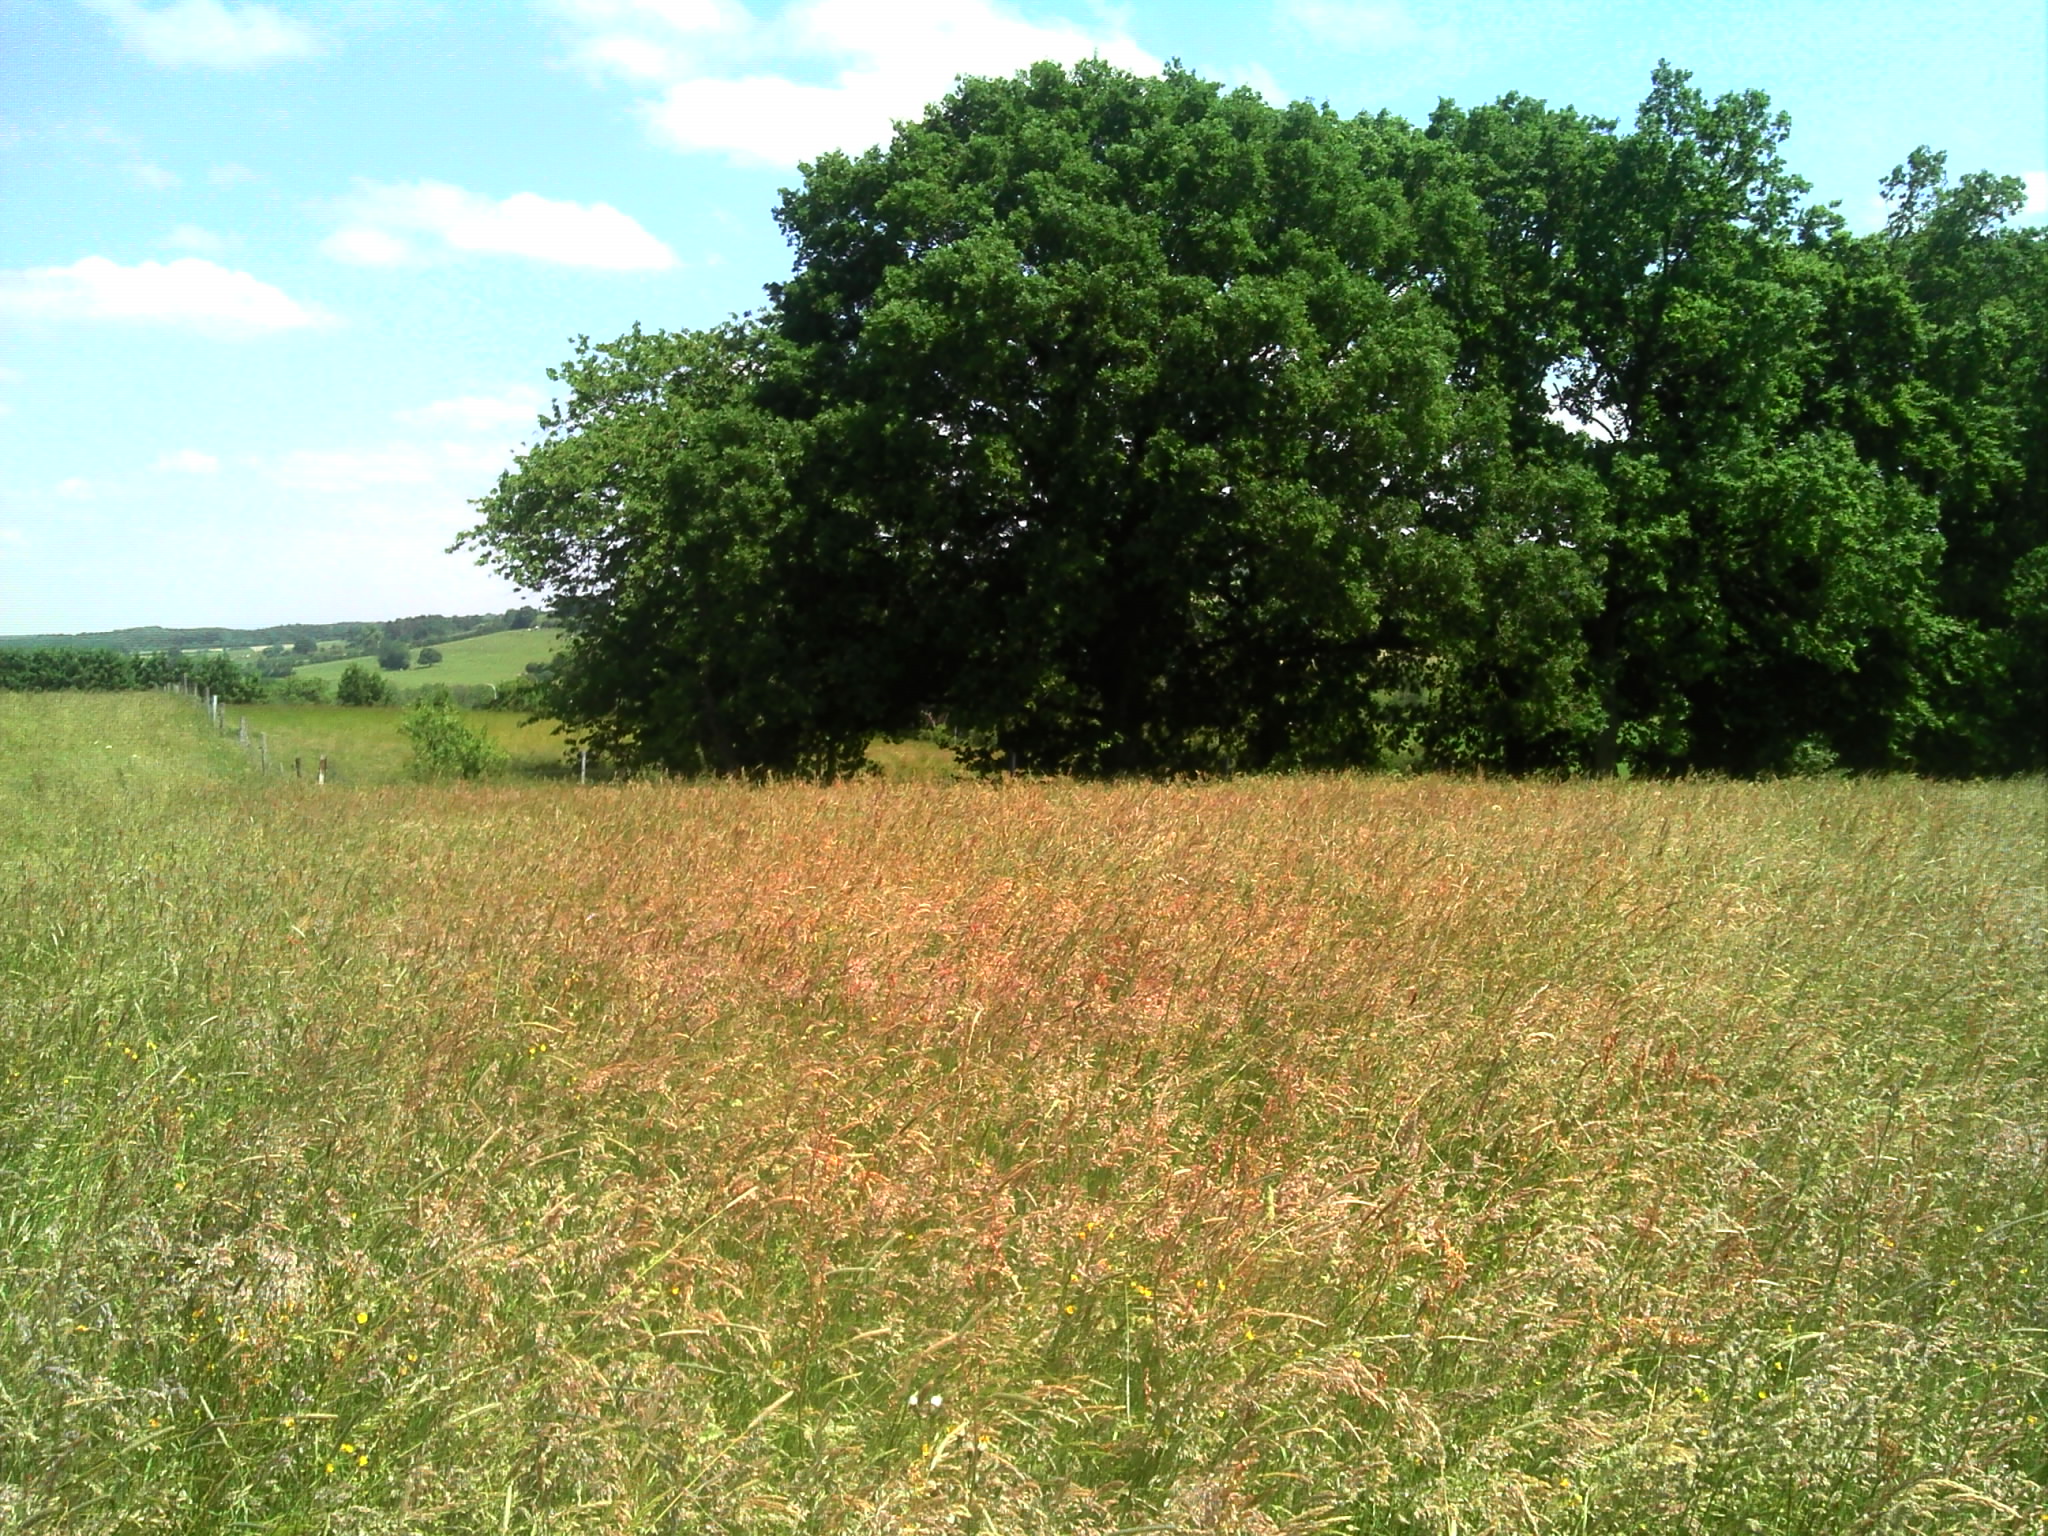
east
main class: Grassland
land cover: Grassland without tree/shrub cover
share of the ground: > 75 %
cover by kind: herbaceous plants 100 %
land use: Agriculture (excluding fallow land and kitchen gardens)
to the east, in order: Grassland without tree/shrub cover; Fences; Broadleaved woodland; Grassland without tree/shrub cover; Managed hedges; Grassland without tree/shrub cover; Pine dominated coniferous woodland; Grassland without tree/shrub cover
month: June
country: BE
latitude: 50.2651
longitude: 5.2420
